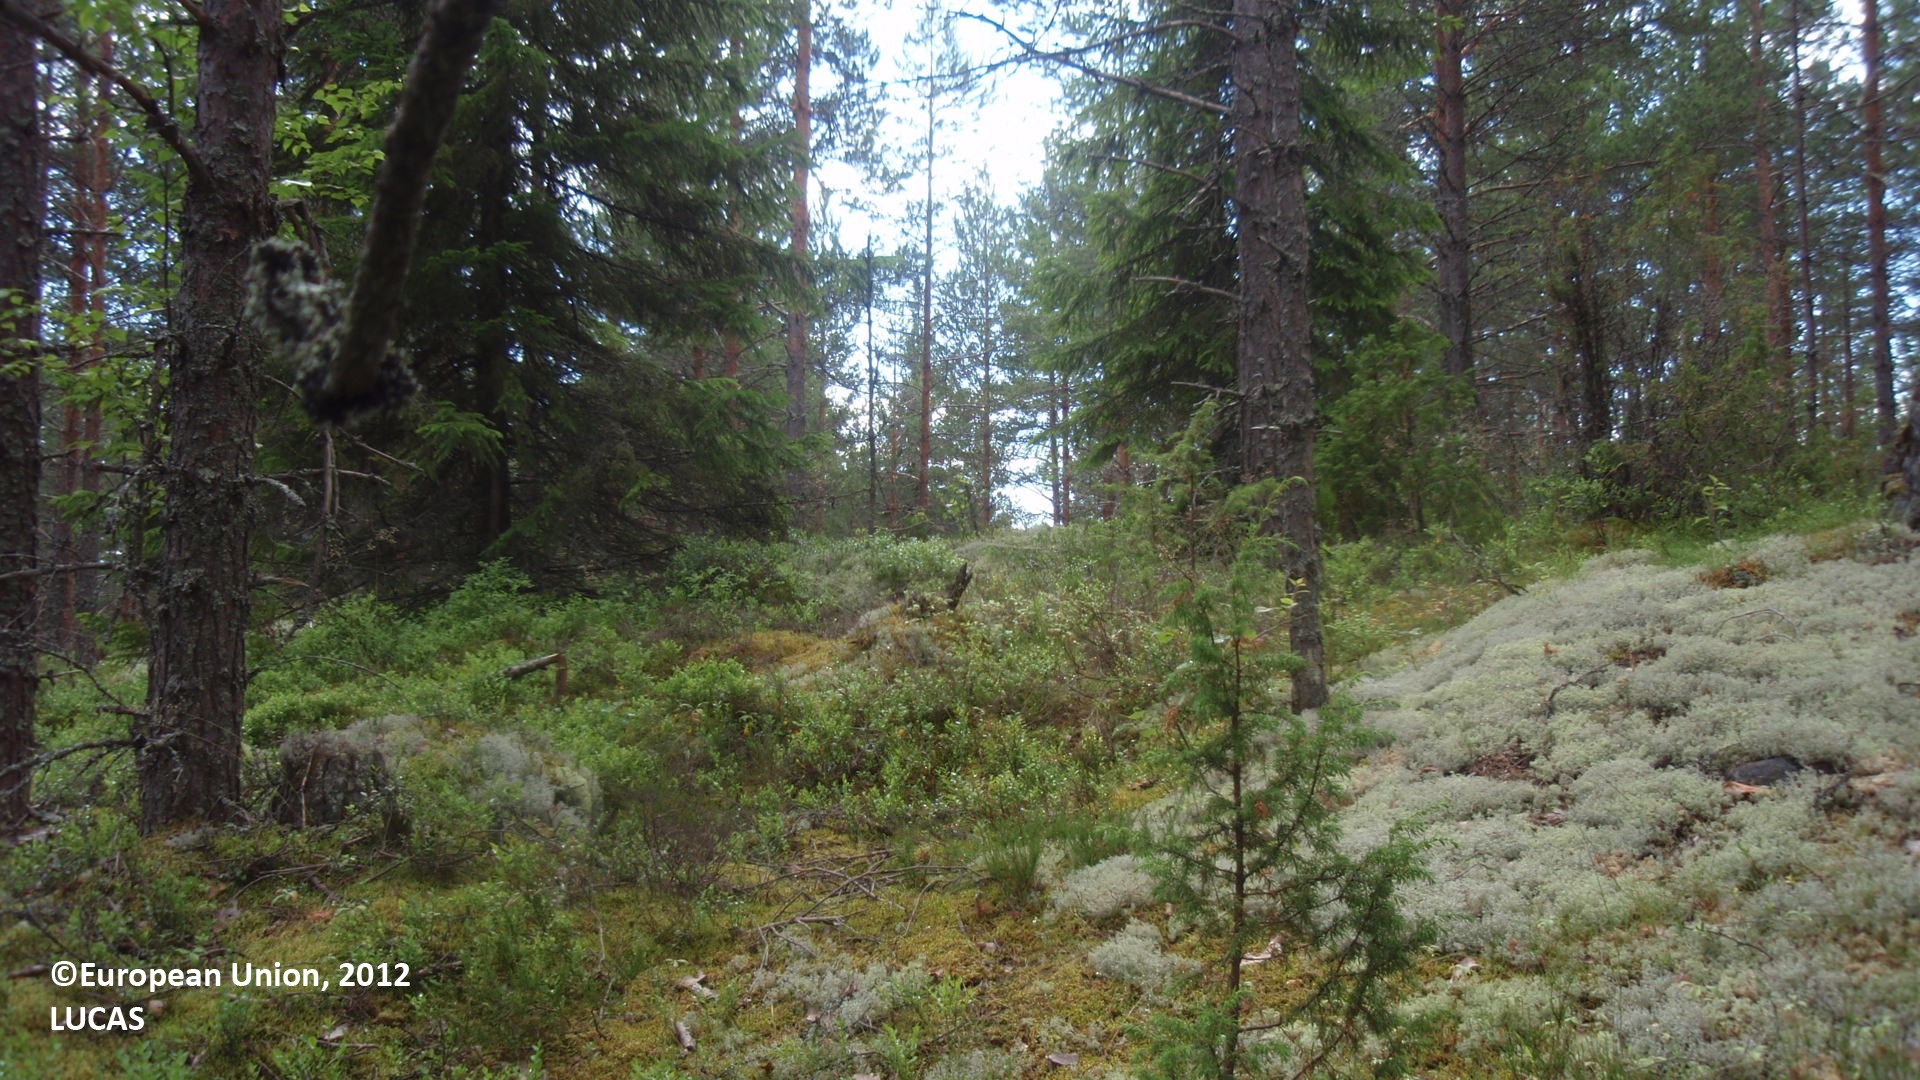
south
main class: Woodland
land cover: Pine dominated coniferous woodland
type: boreal forest
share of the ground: 50 - 75 %
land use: Forestry
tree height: > 5 m
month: July
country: FI
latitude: 61.4235
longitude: 28.4066
